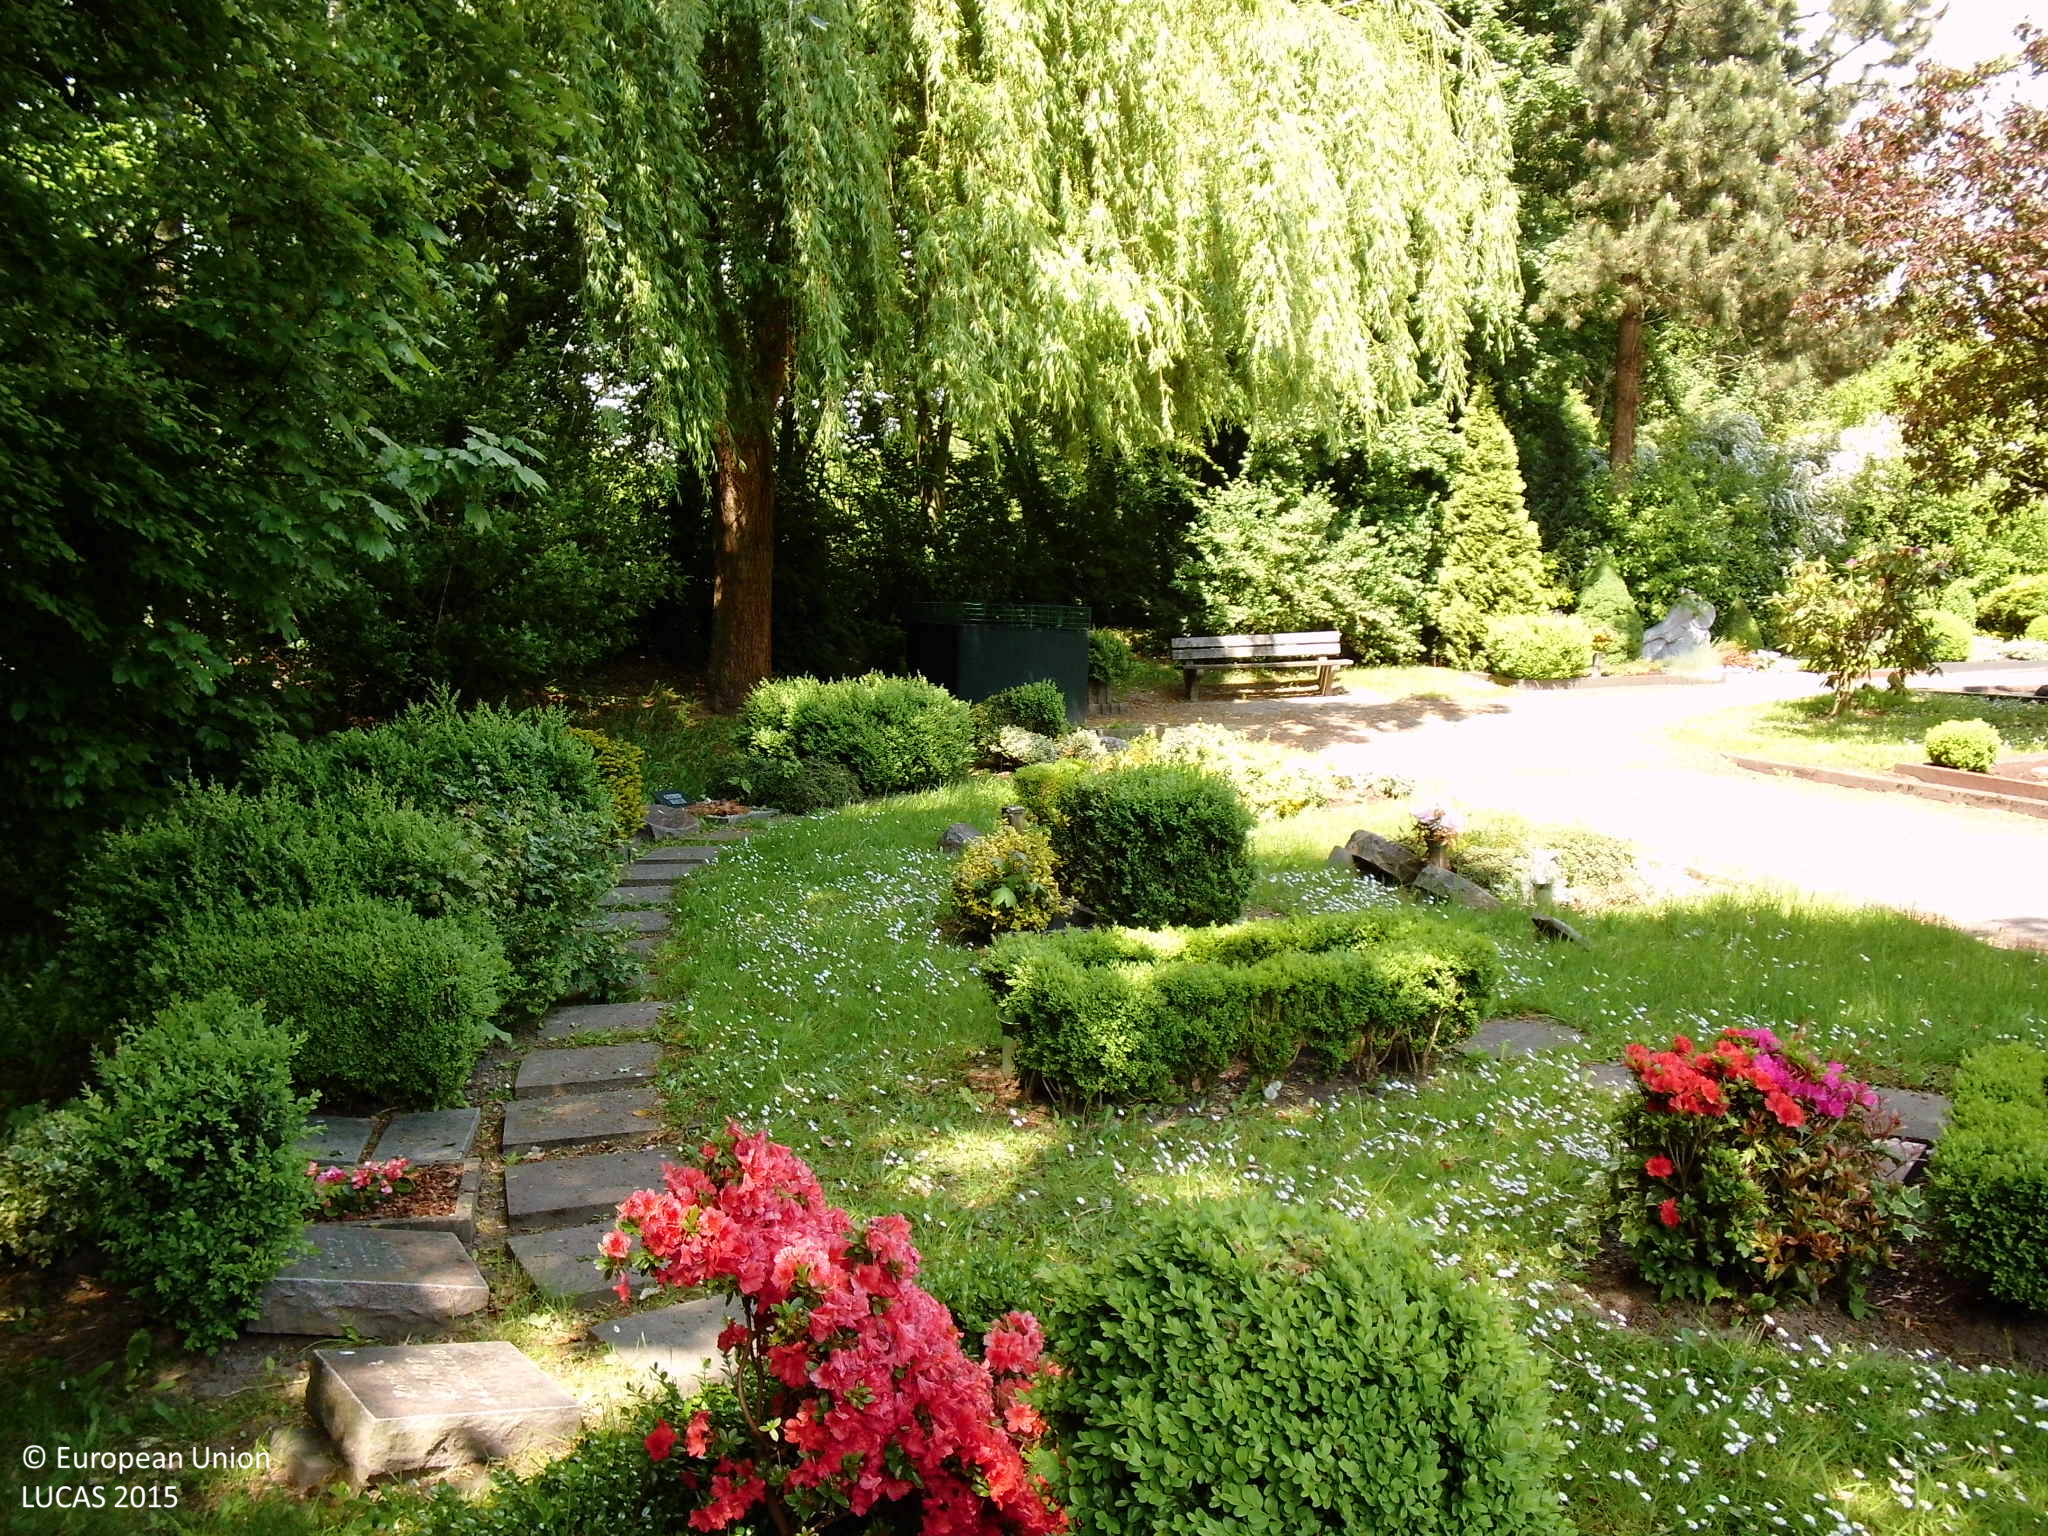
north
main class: Woodland
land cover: Broadleaved woodland
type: beech forest
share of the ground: 25 - 50 %
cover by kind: broadleaved forest trees 40 %, herbaceous plants 30 %, shrubs 20 %, consolidated bare surface 5 %, unconsolidated bare surface 5 %
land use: Community services
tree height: > 5 m
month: May
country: DE
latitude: 51.6293
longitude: 7.3854
